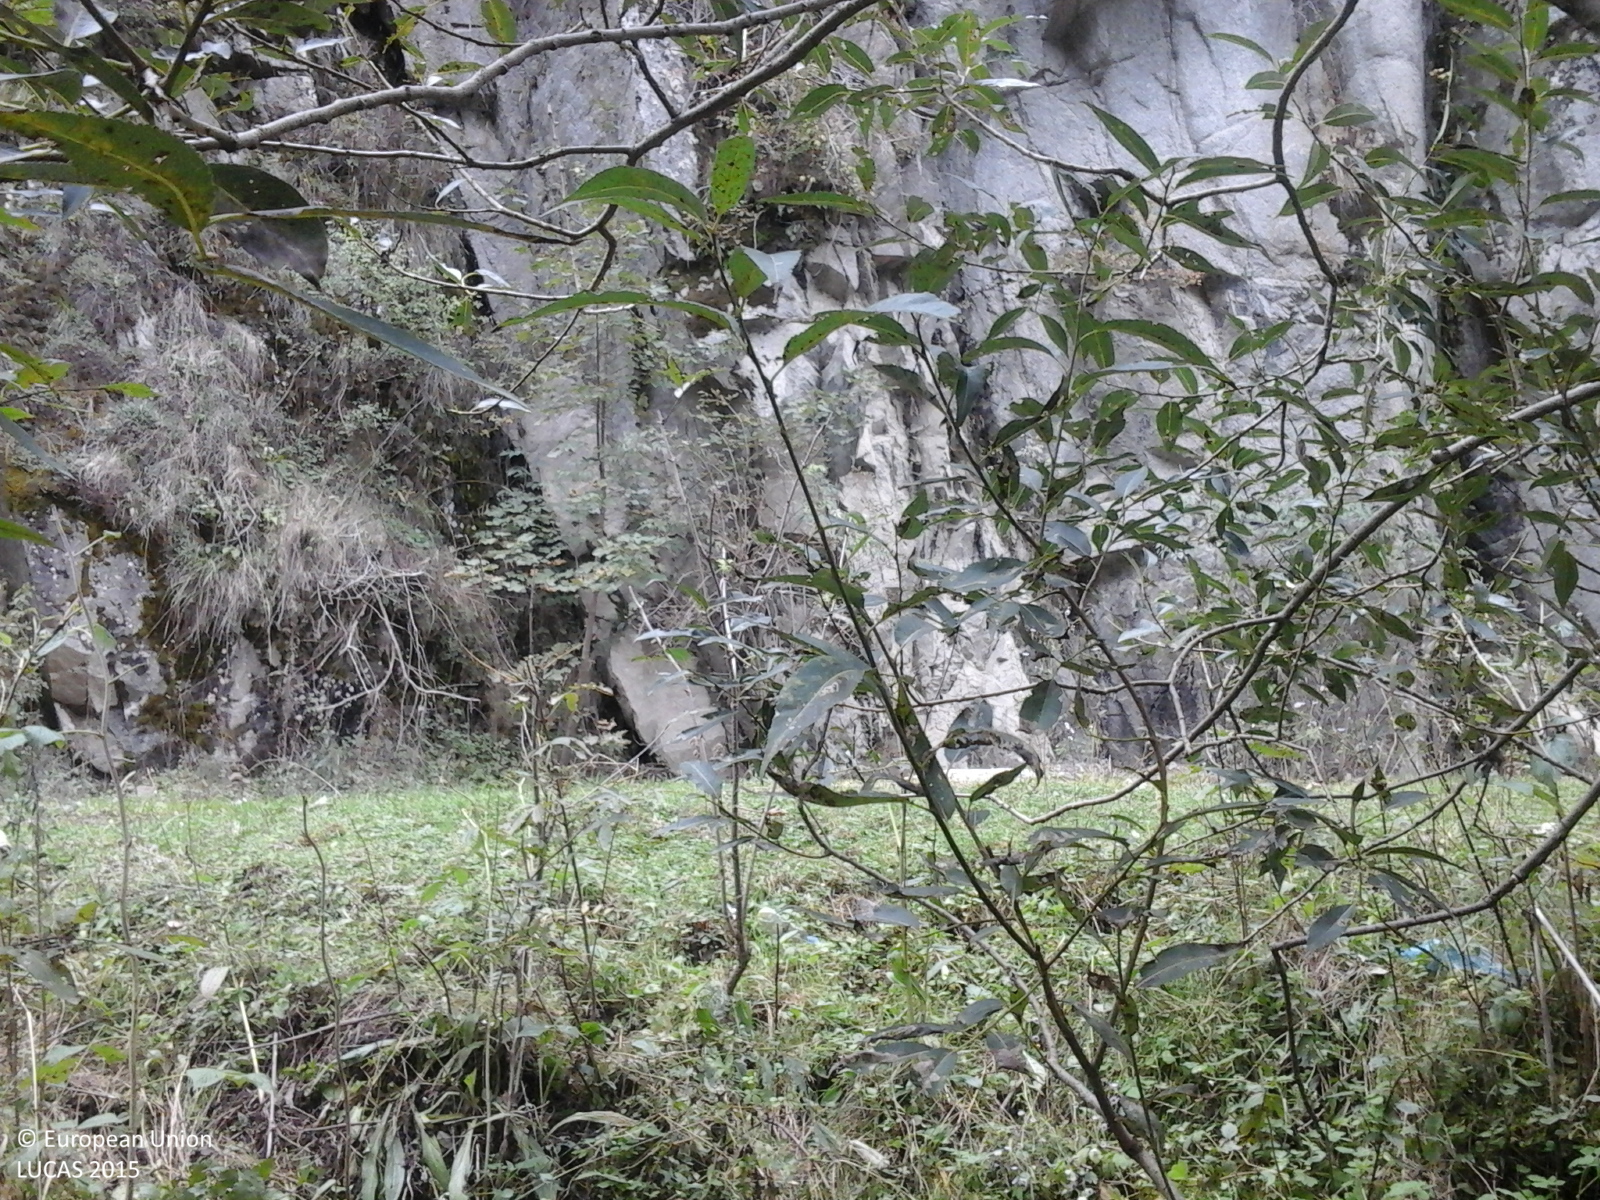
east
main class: Woodland
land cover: Broadleaved woodland
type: exotic forest
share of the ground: > 75 %
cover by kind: broadleaved forest trees 100 %
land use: Forestry
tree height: > 5 m
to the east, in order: Broadleaved woodland; Paved roads, cycling and walking lanes; Rocks and stones; Spruce dominated coniferous woodland
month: October
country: RO
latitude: 46.6279
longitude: 23.1628
